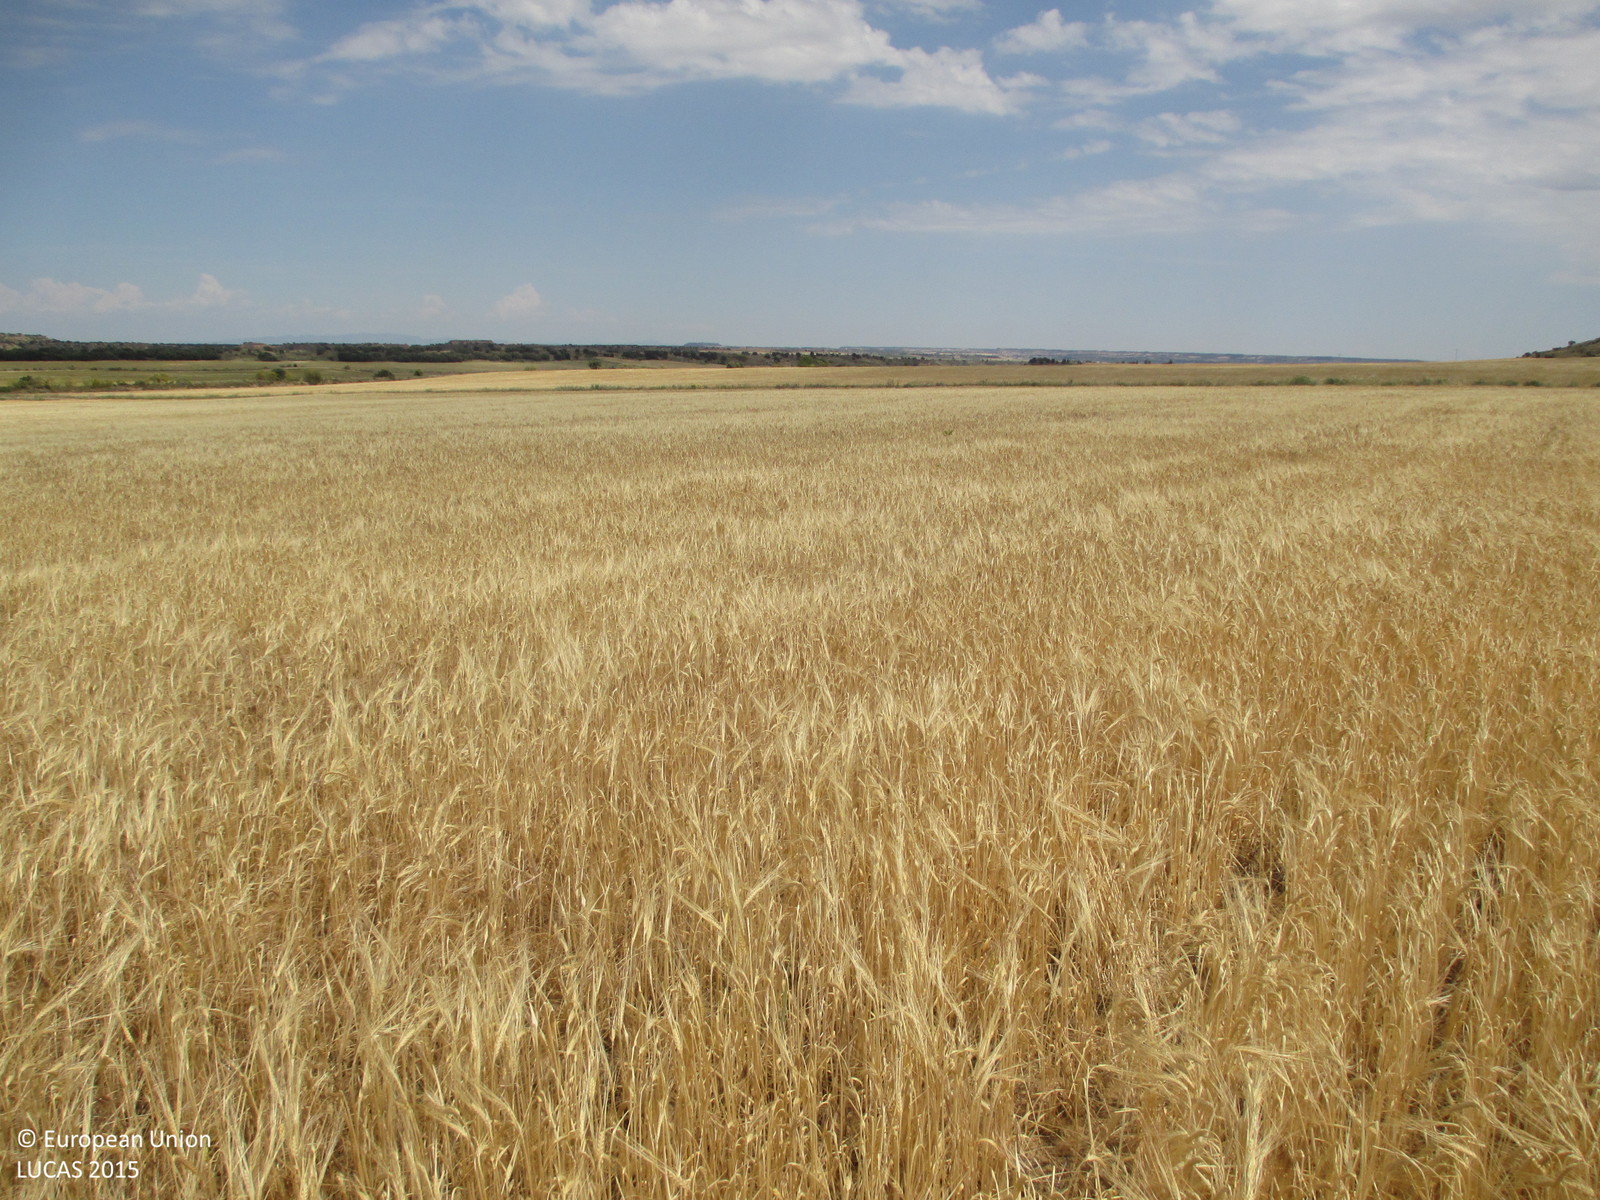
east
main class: Cropland
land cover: Barley
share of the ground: > 75 %
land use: Agriculture (excluding fallow land and kitchen gardens)
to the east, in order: Barley; Shruby margins; Paved roads, cycling and walking lanes; Shruby margins; Barley
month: May
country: ES
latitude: 41.9545
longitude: -0.2139
